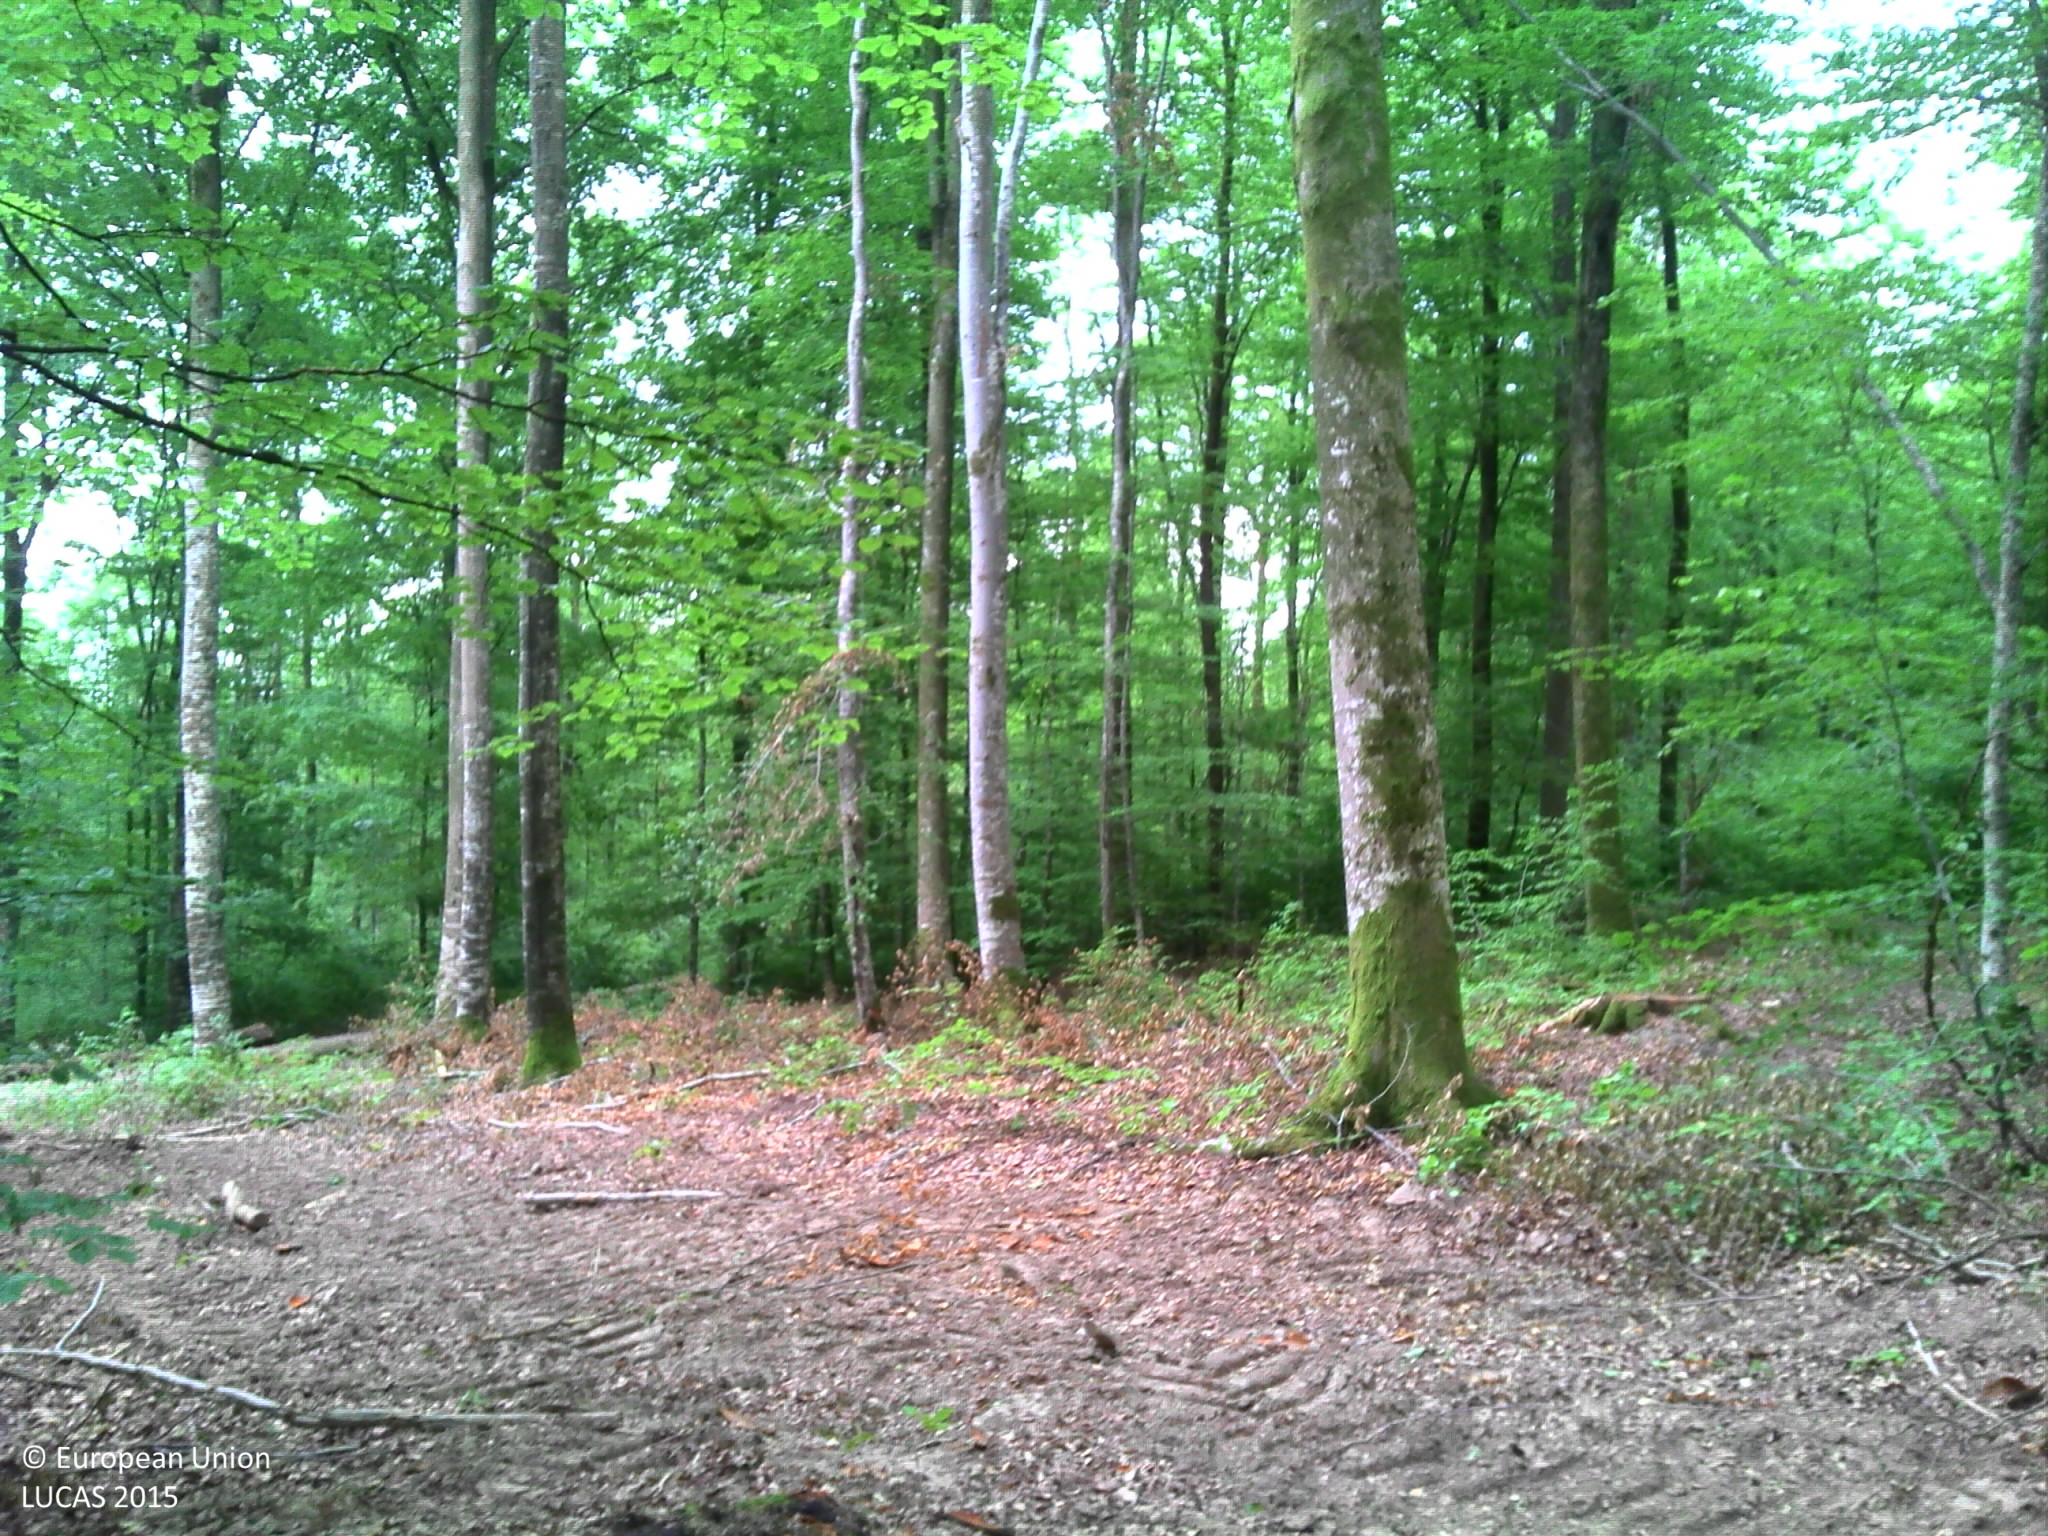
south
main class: Woodland
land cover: Broadleaved woodland
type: beech forest
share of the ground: > 75 %
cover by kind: broadleaved forest trees 90 %, coniferous forest trees 5 %, herbaceous plants 5 %
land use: Forestry
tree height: > 5 m
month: May
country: FR
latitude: 47.9925
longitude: 6.1011
